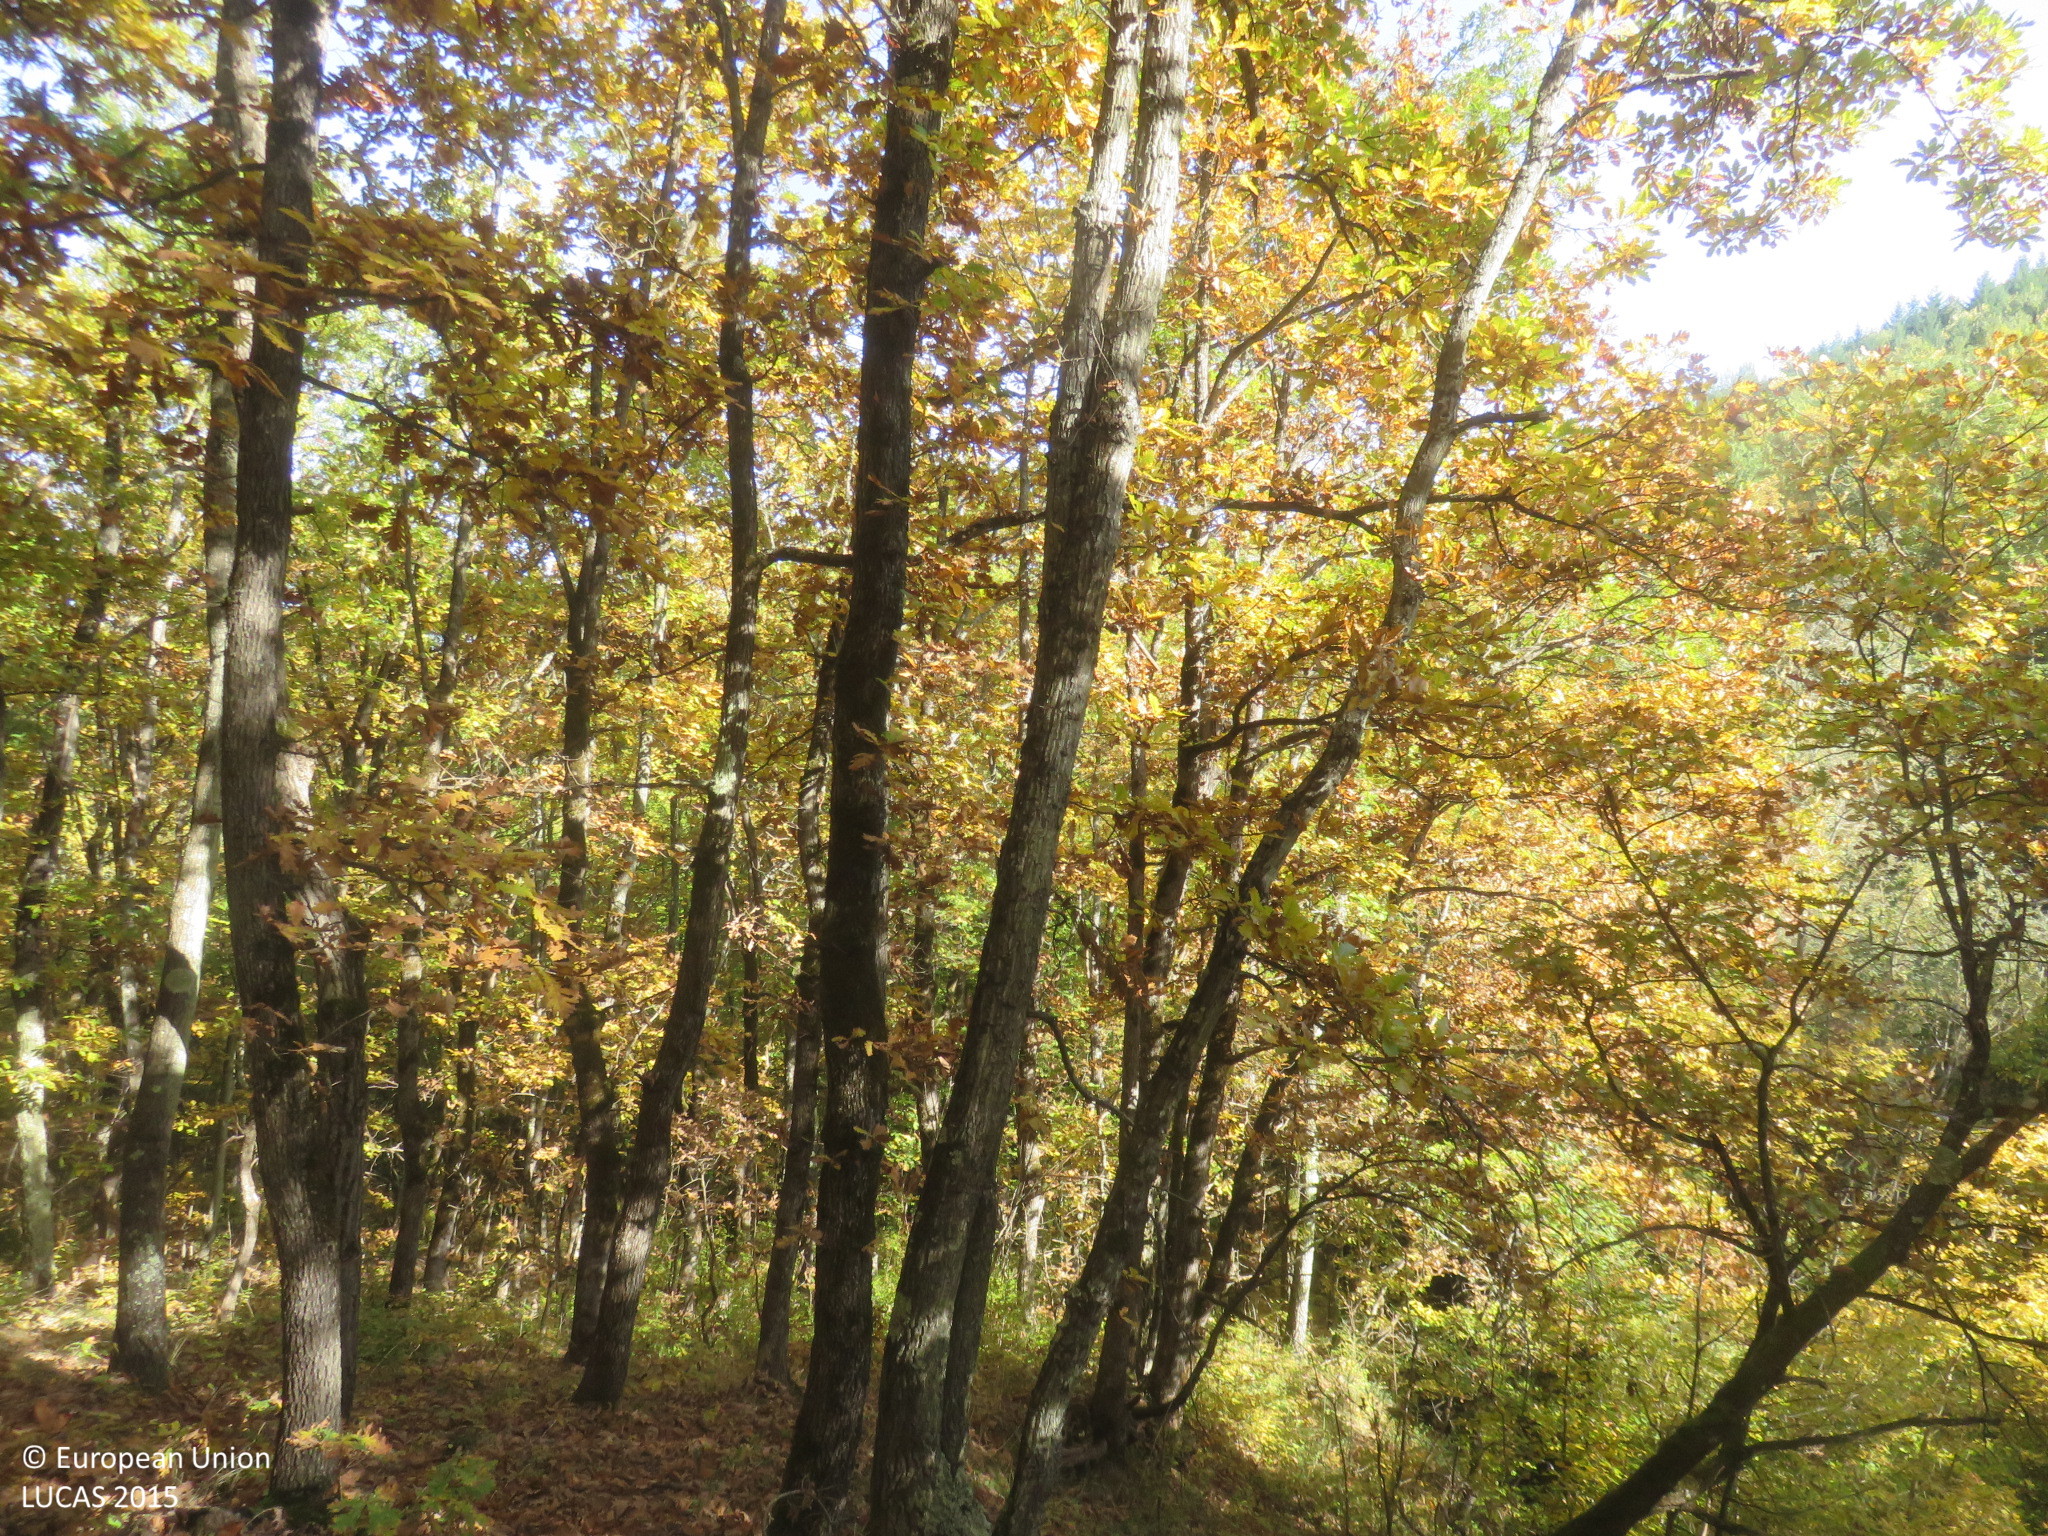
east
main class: Woodland
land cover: Broadleaved woodland
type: mesophytic deciduous forest
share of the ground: > 75 %
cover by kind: broadleaved forest trees 90 %, coniferous forest trees 10 %
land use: Forestry
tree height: > 5 m
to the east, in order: Broadleaved woodland
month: October
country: BG
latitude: 42.9552
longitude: 24.7828
